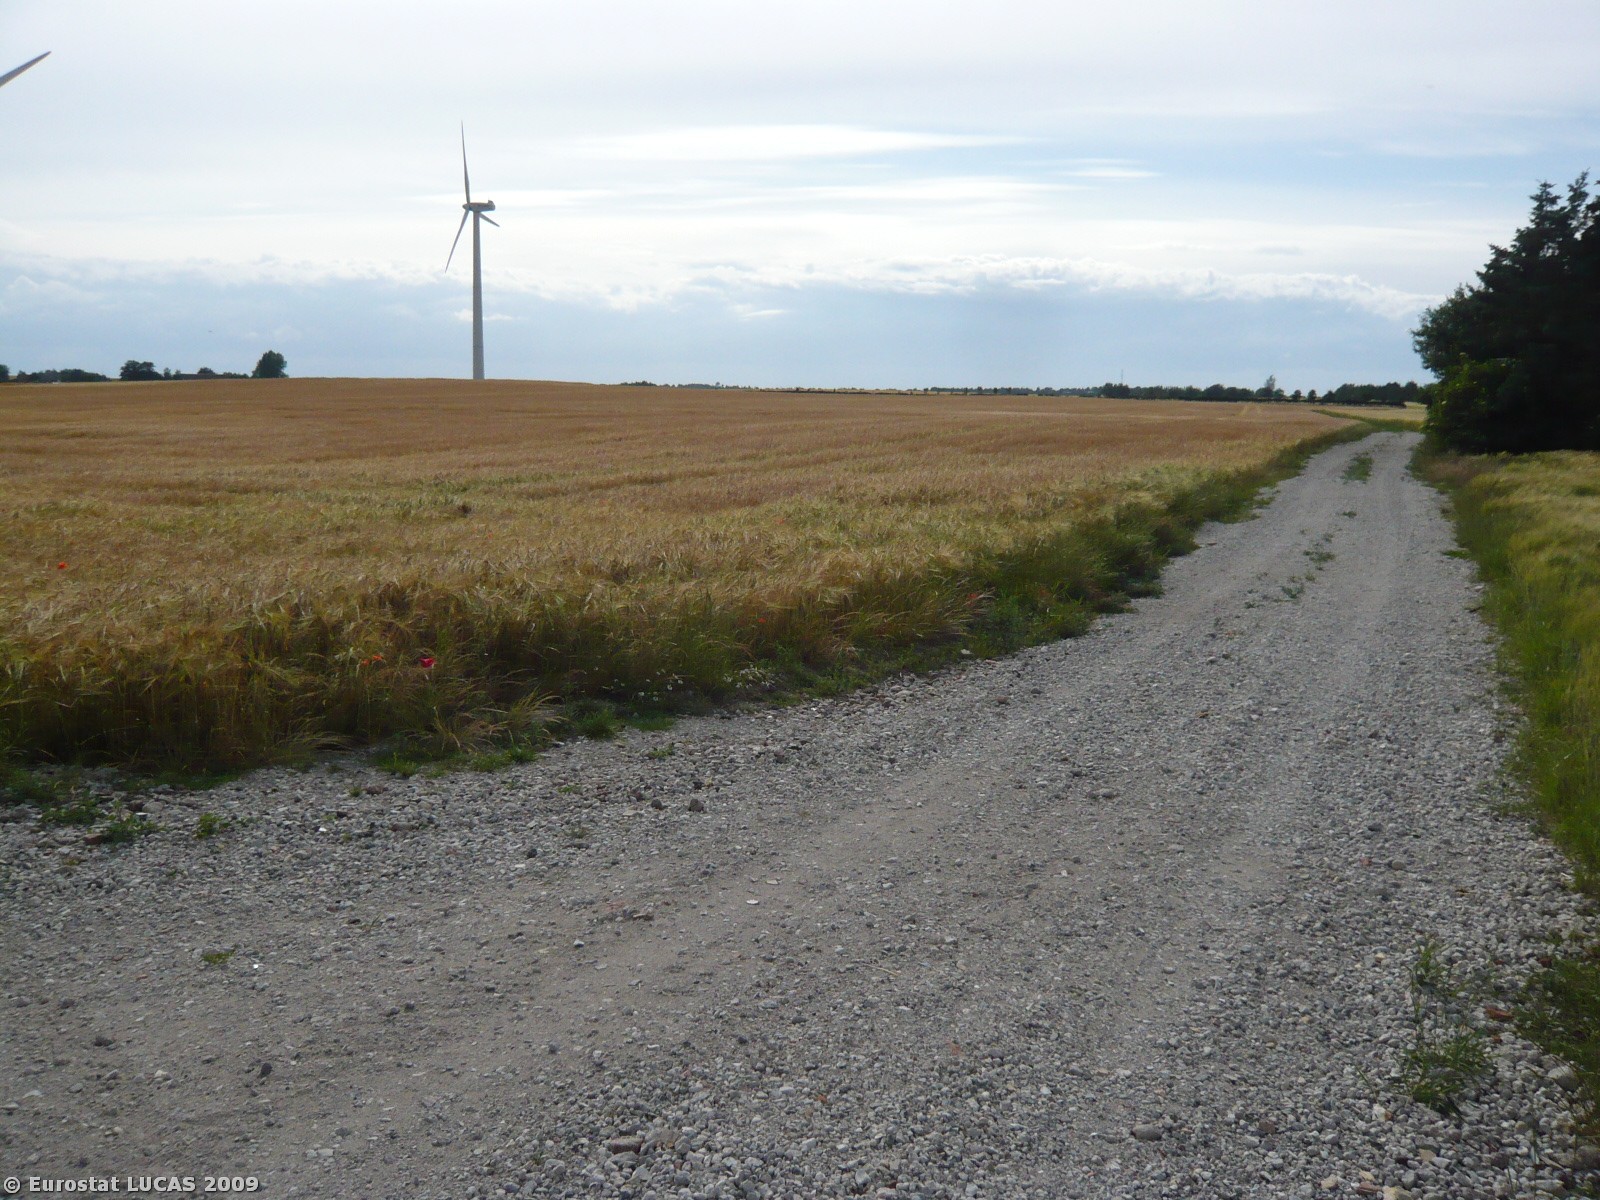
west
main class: Cropland
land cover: Barley
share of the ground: > 75 %
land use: Agriculture (excluding fallow land and kitchen gardens)
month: July
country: DK
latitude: 55.4267
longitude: 11.2472
